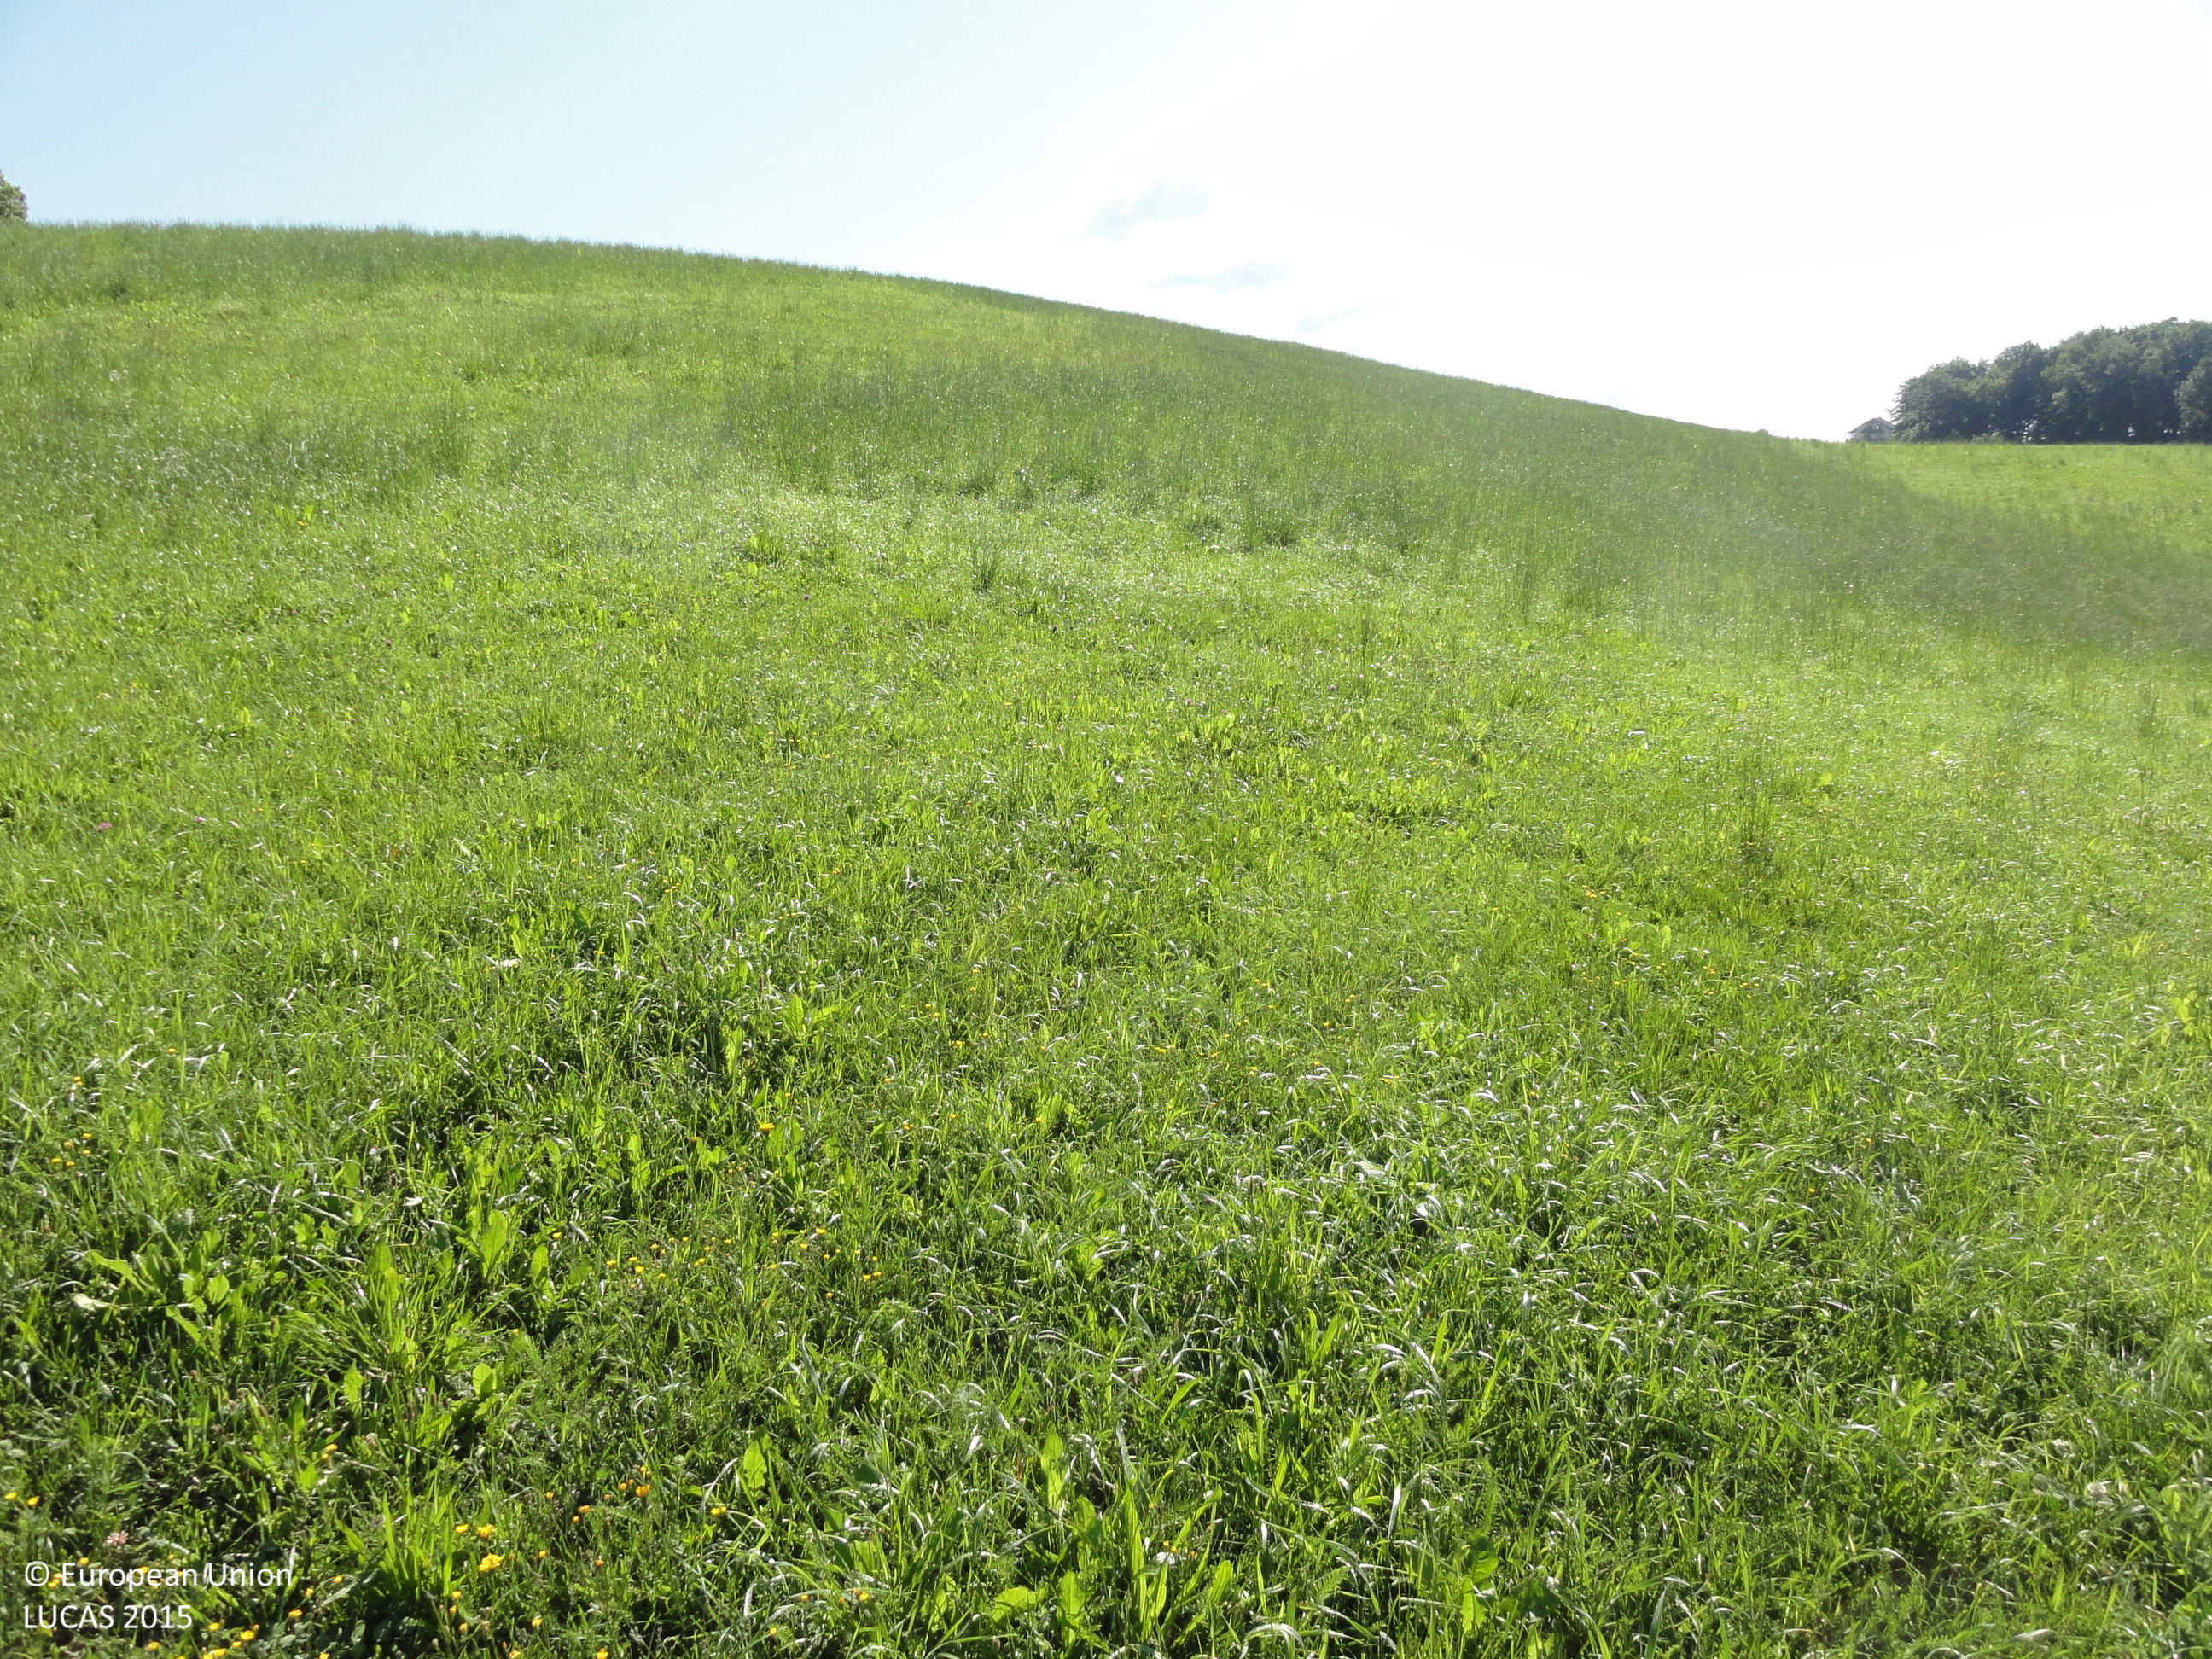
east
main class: Grassland
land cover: Grassland without tree/shrub cover
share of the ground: > 75 %
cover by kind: herbaceous plants 100 %
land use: Agriculture (excluding fallow land and kitchen gardens)
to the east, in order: Grassland without tree/shrub cover; Tracks; Grassland without tree/shrub cover; Ditches and canals; Grassland without tree/shrub cover; Dry pulses; Maize; Ditches and canals; Grass margins; Tracks; Grassland without tree/shrub cover
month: June
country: SI
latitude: 46.2646
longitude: 15.4863
